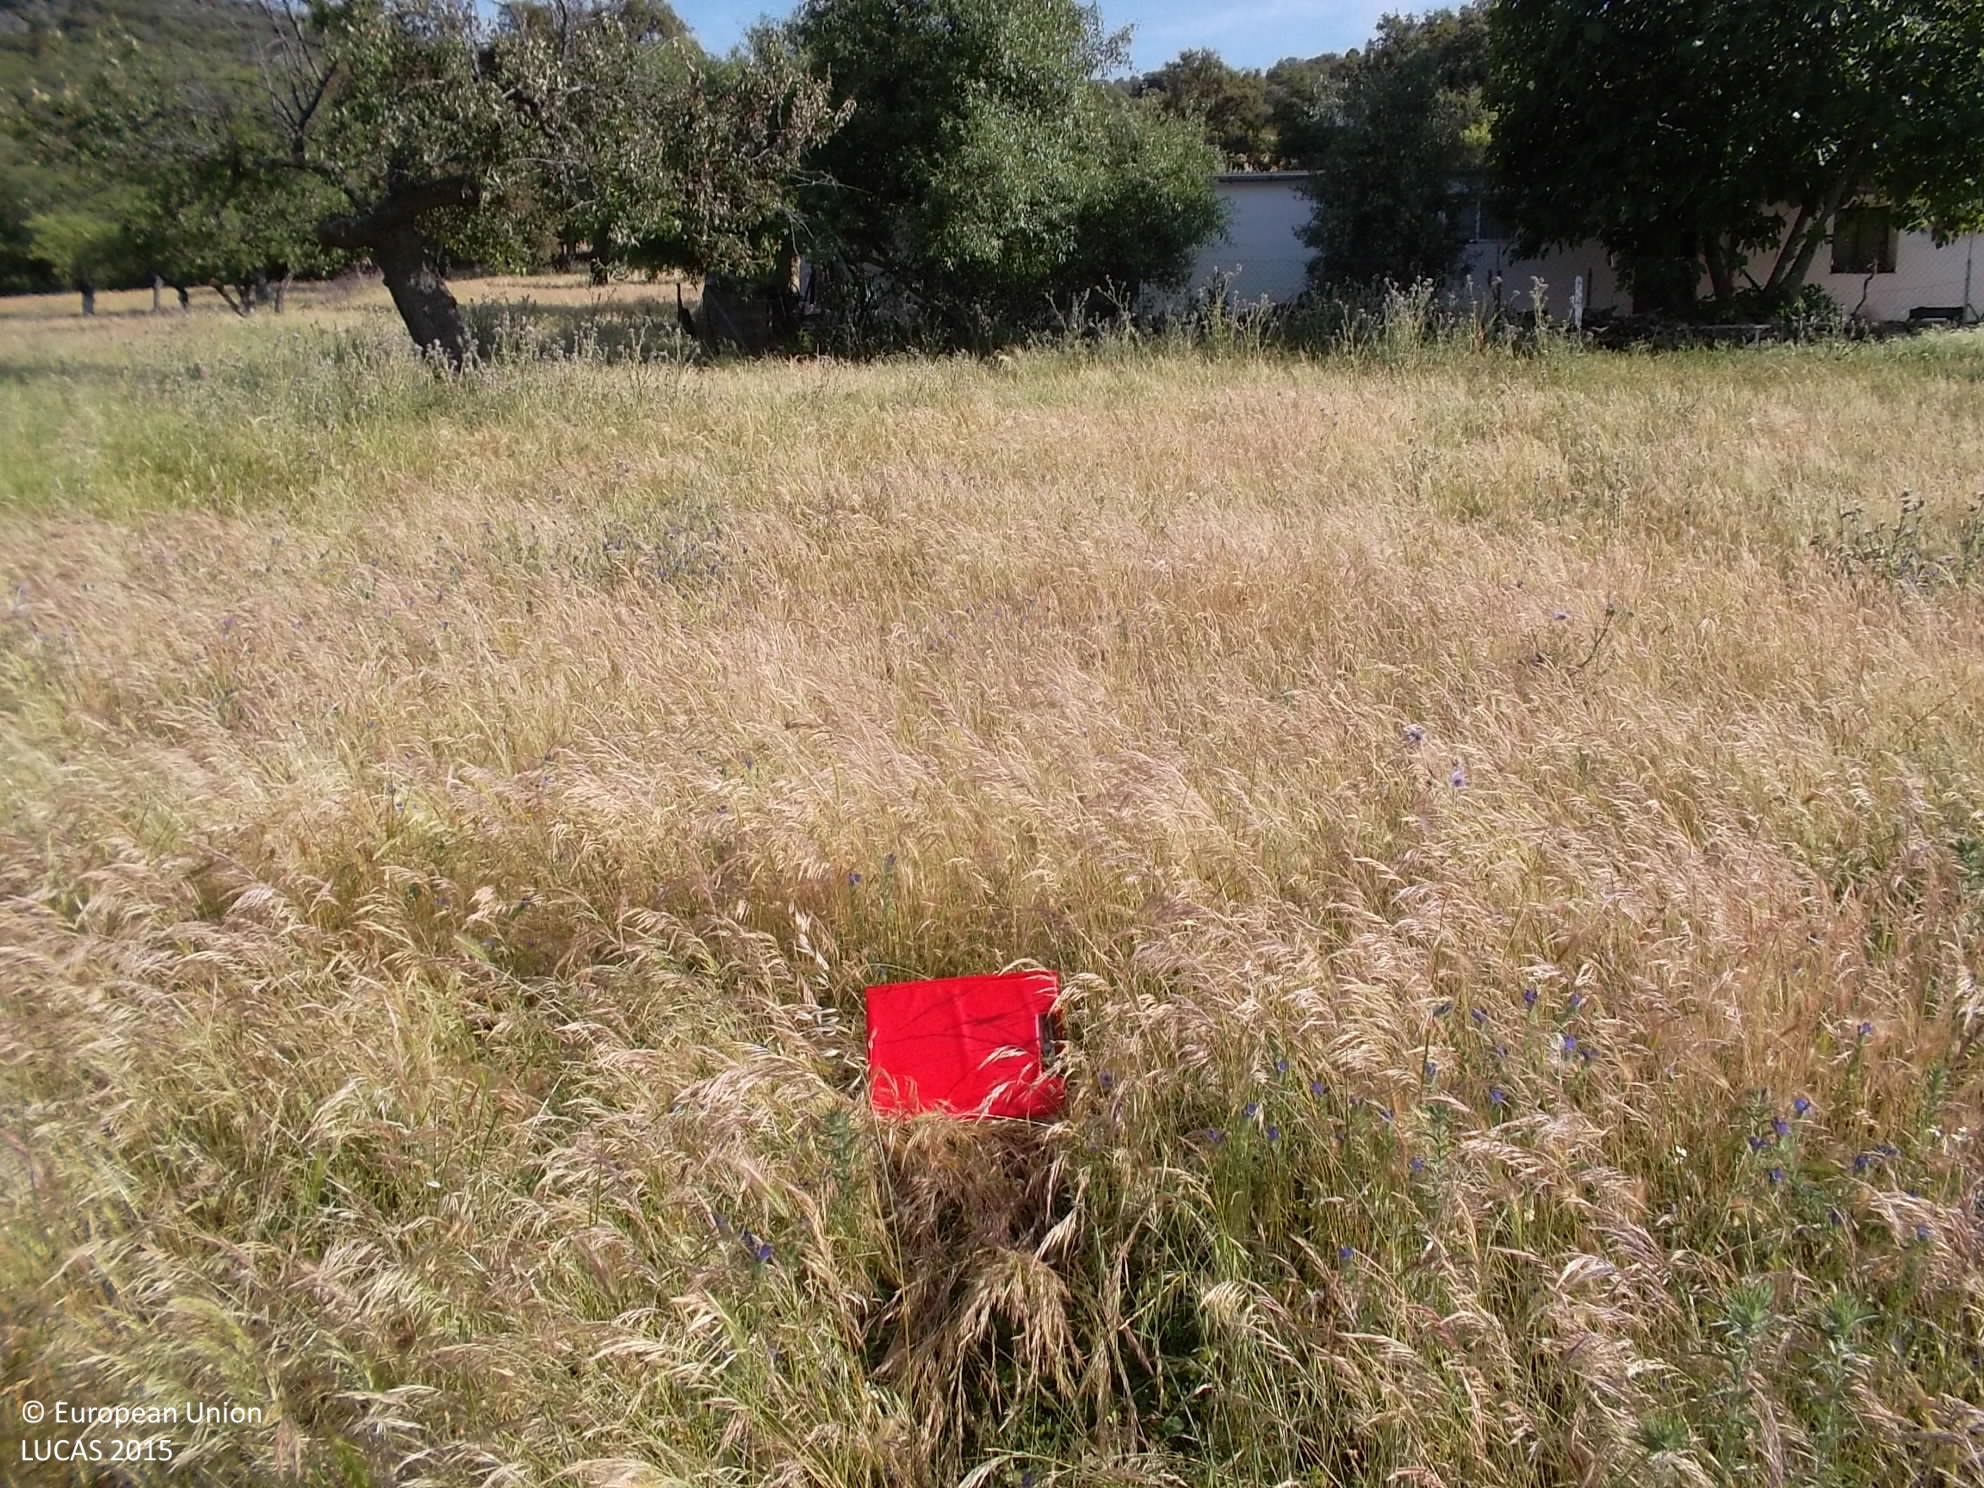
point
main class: Grassland
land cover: Grassland without tree/shrub cover
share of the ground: > 75 %
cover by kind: herbaceous plants 100 %
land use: Agriculture (excluding fallow land and kitchen gardens)
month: May
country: ES
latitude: 38.7677
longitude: -4.8185
